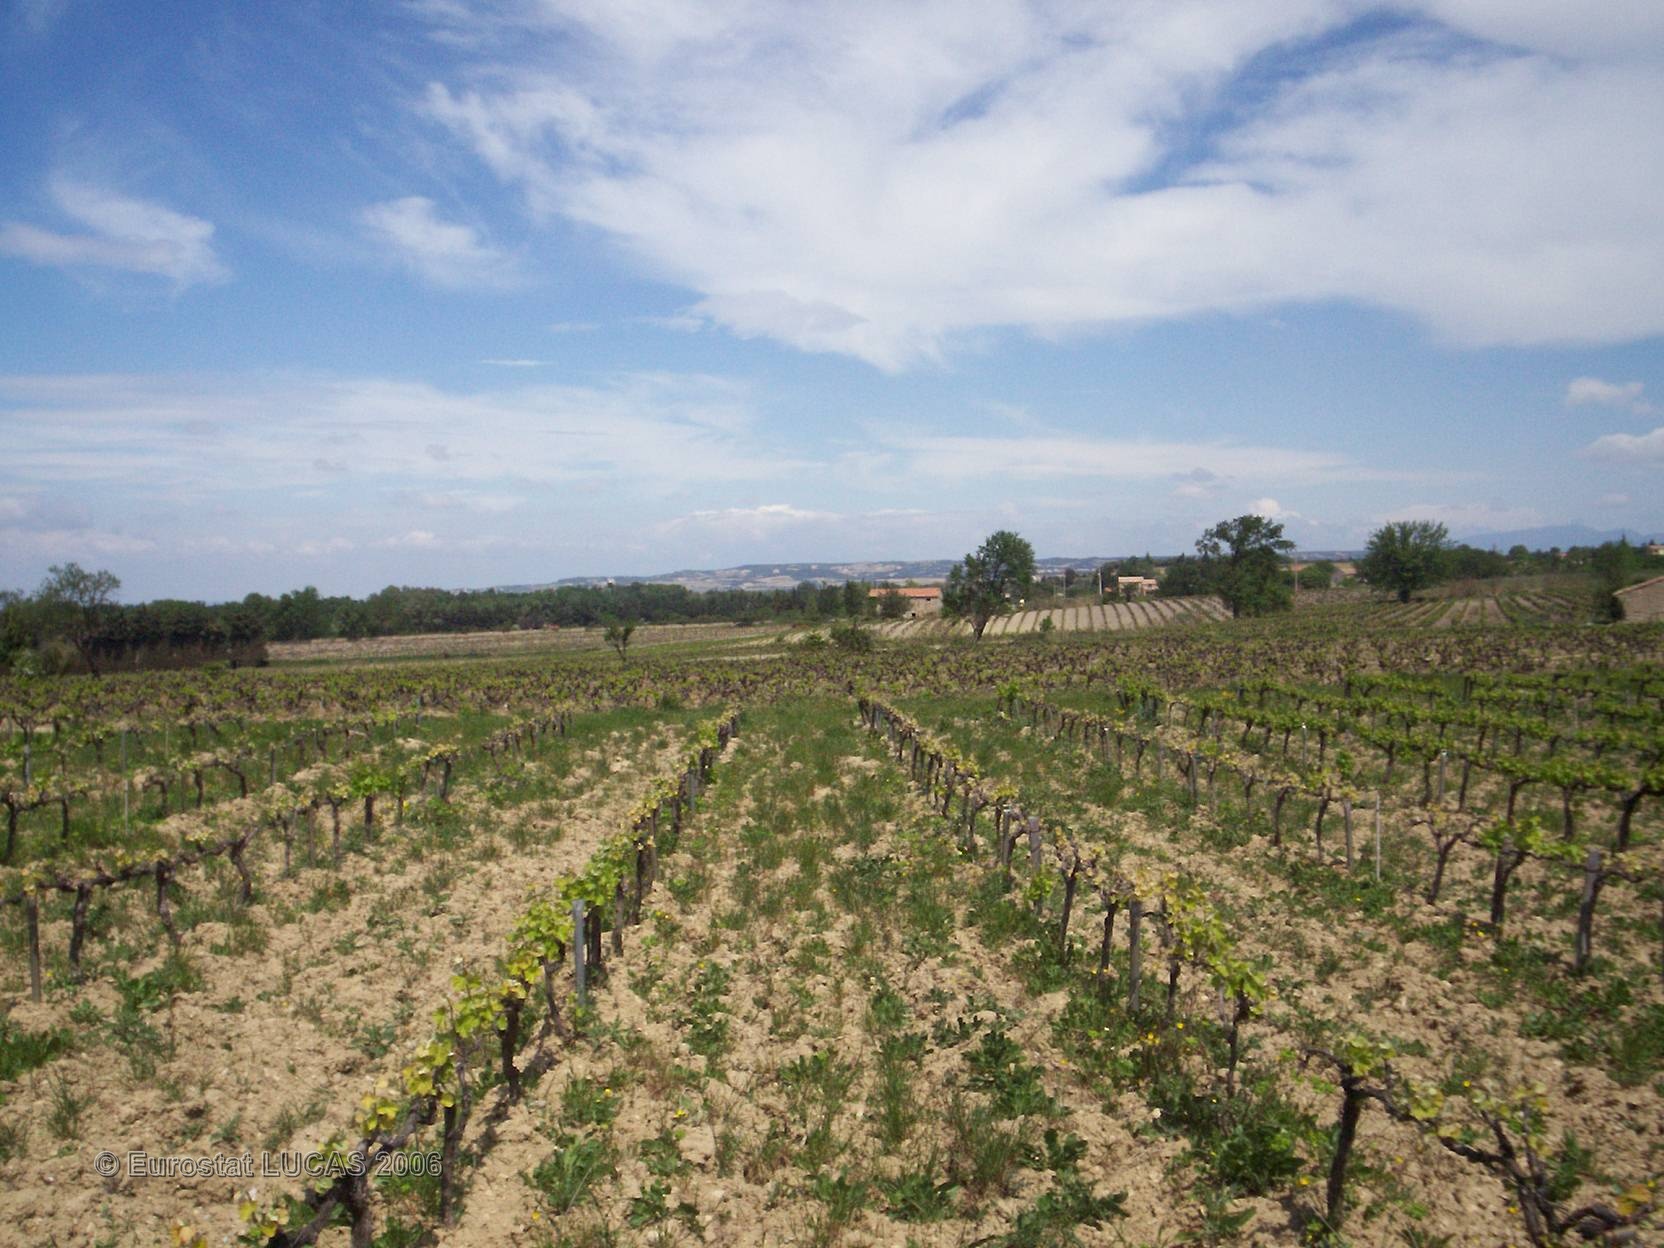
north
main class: Cropland
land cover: Vineyards
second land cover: Grassland with sparse tree/shrub cover
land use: Agriculture (excluding fallow land and kitchen gardens)
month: April
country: FR
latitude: 44.1563
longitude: 4.9690
